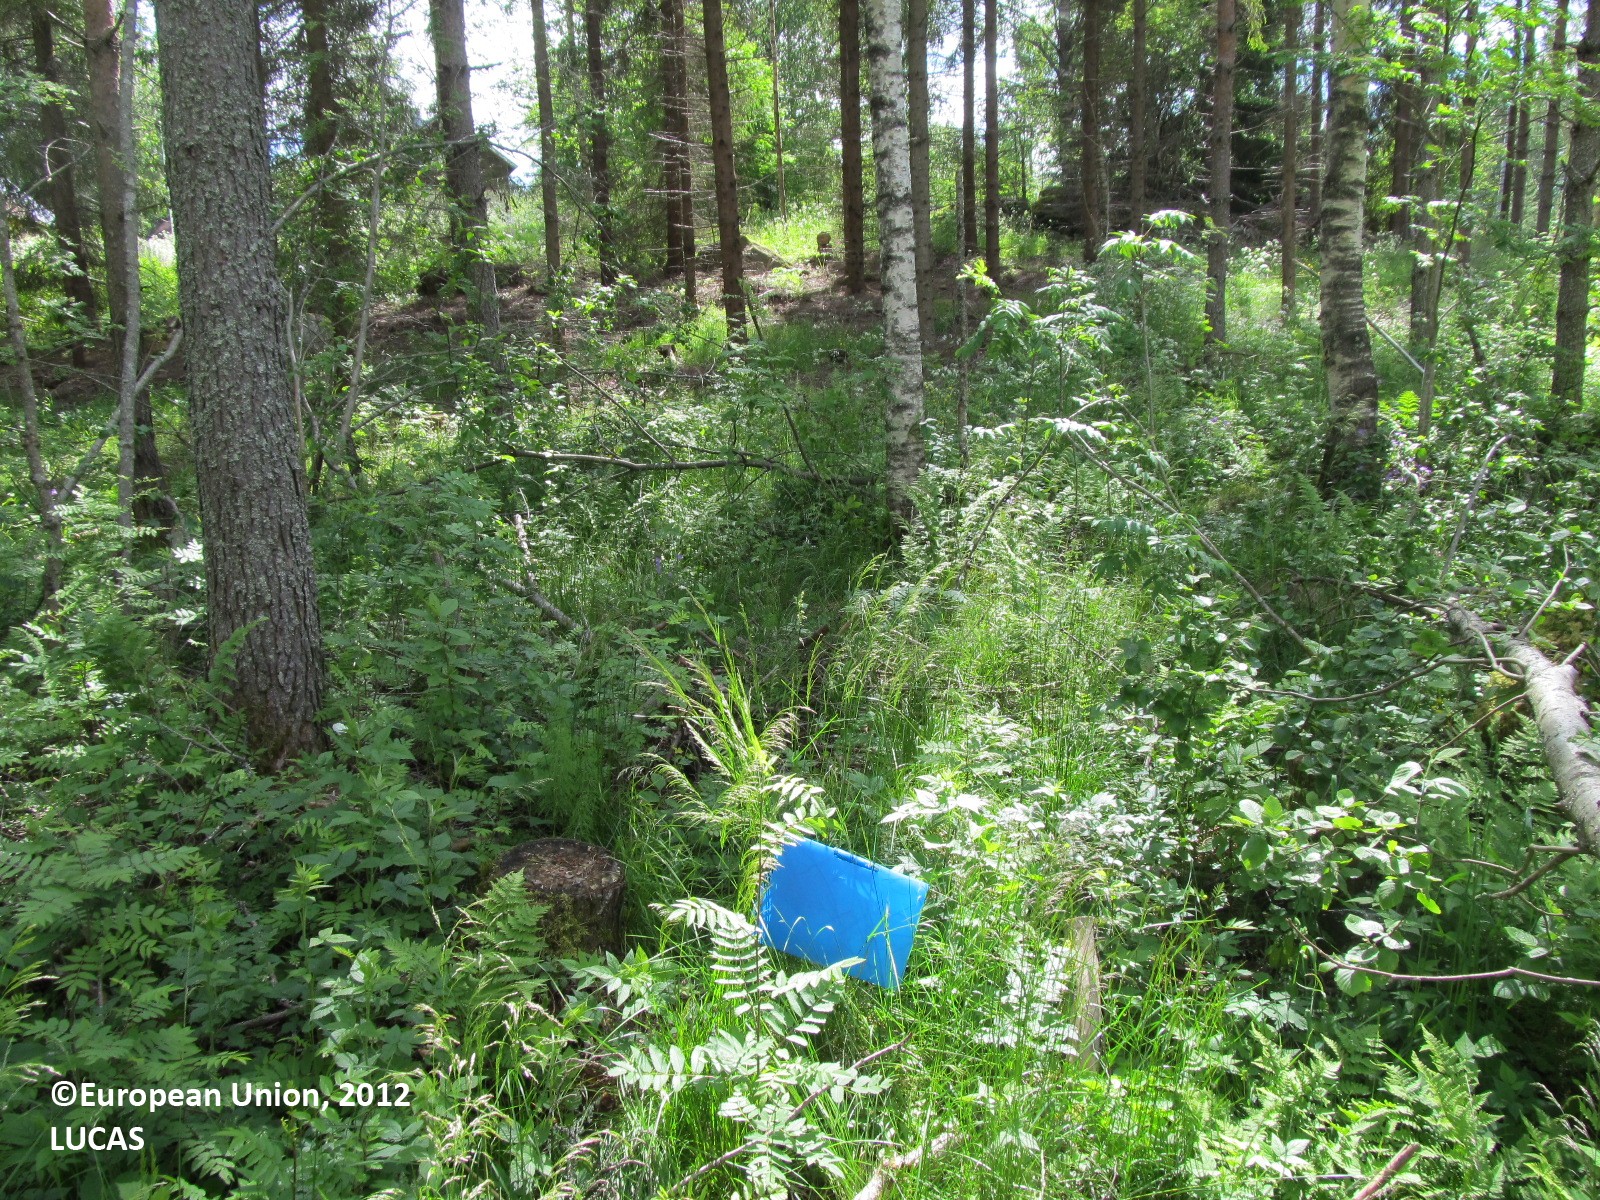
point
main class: Woodland
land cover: Pine dominated coniferous woodland
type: boreal forest
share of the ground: 25 - 50 %
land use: Forestry
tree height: > 5 m
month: June
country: FI
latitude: 62.7099
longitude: 28.8425
